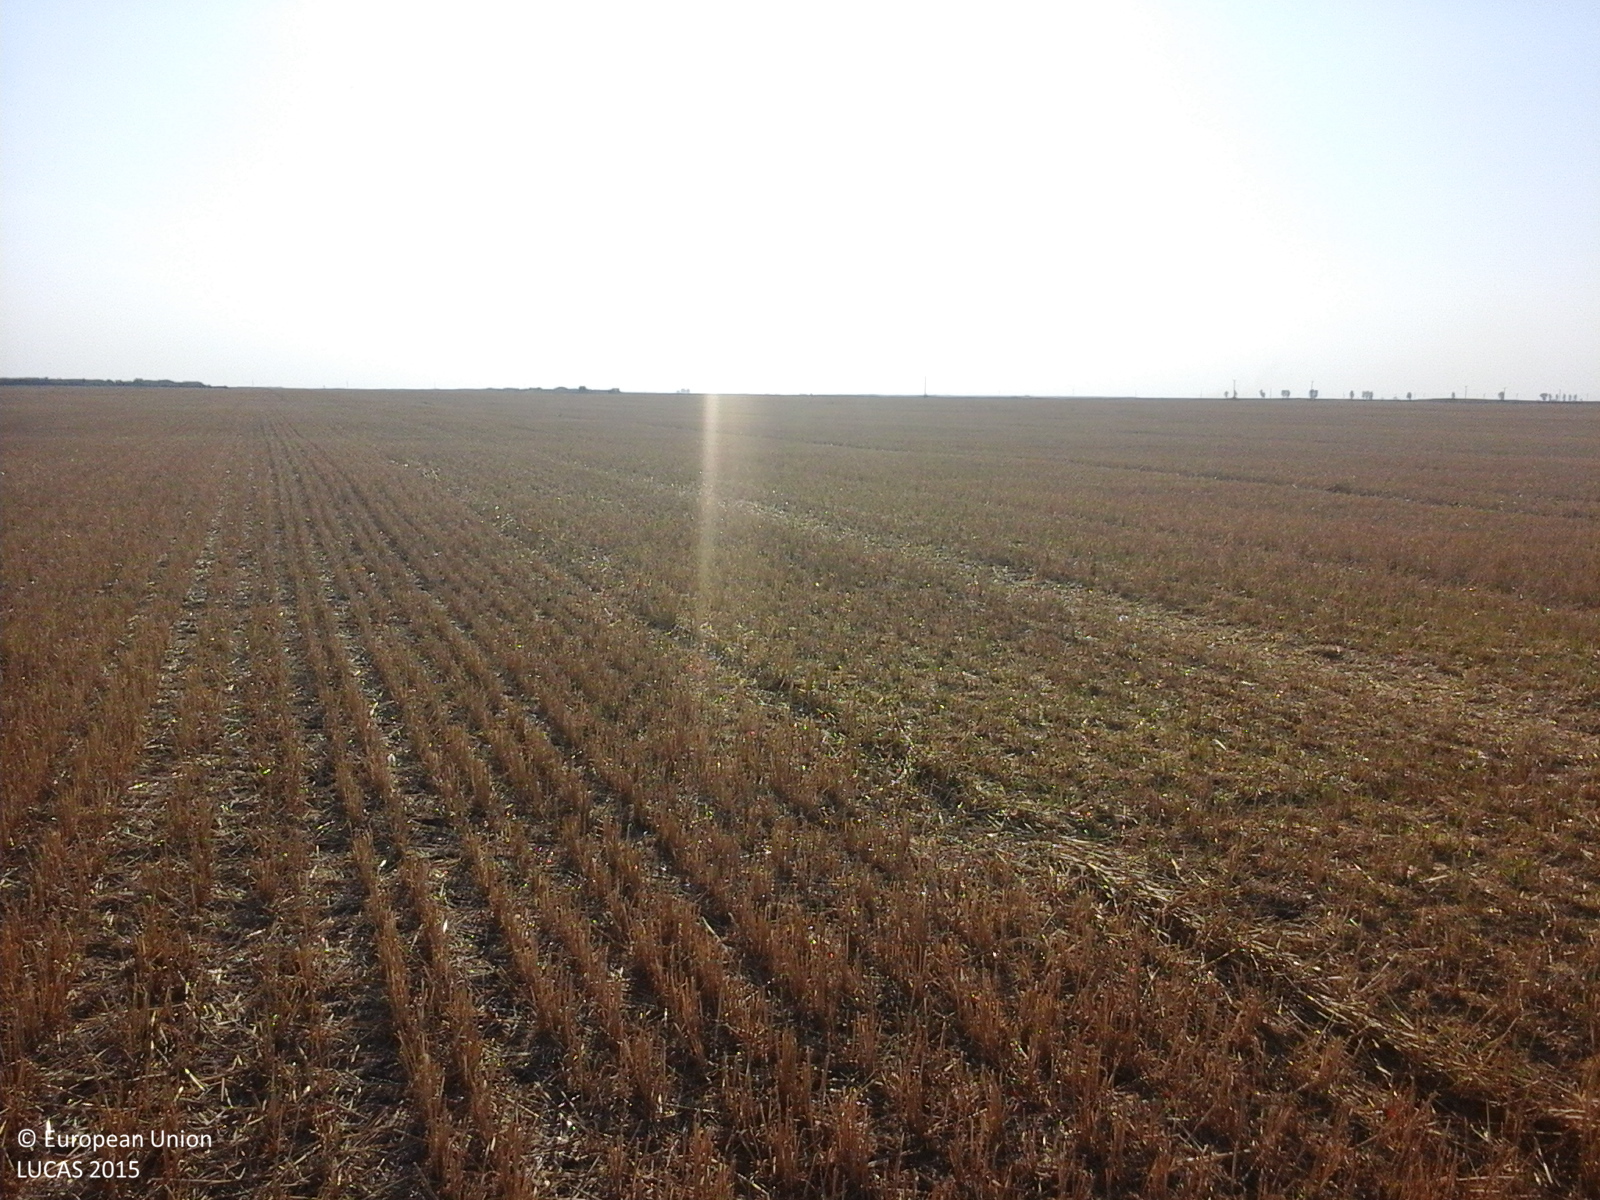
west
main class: Cropland
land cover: Common wheat
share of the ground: < 10 %
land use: Agriculture (excluding fallow land and kitchen gardens)
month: July
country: RO
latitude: 44.9960
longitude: 27.3316
